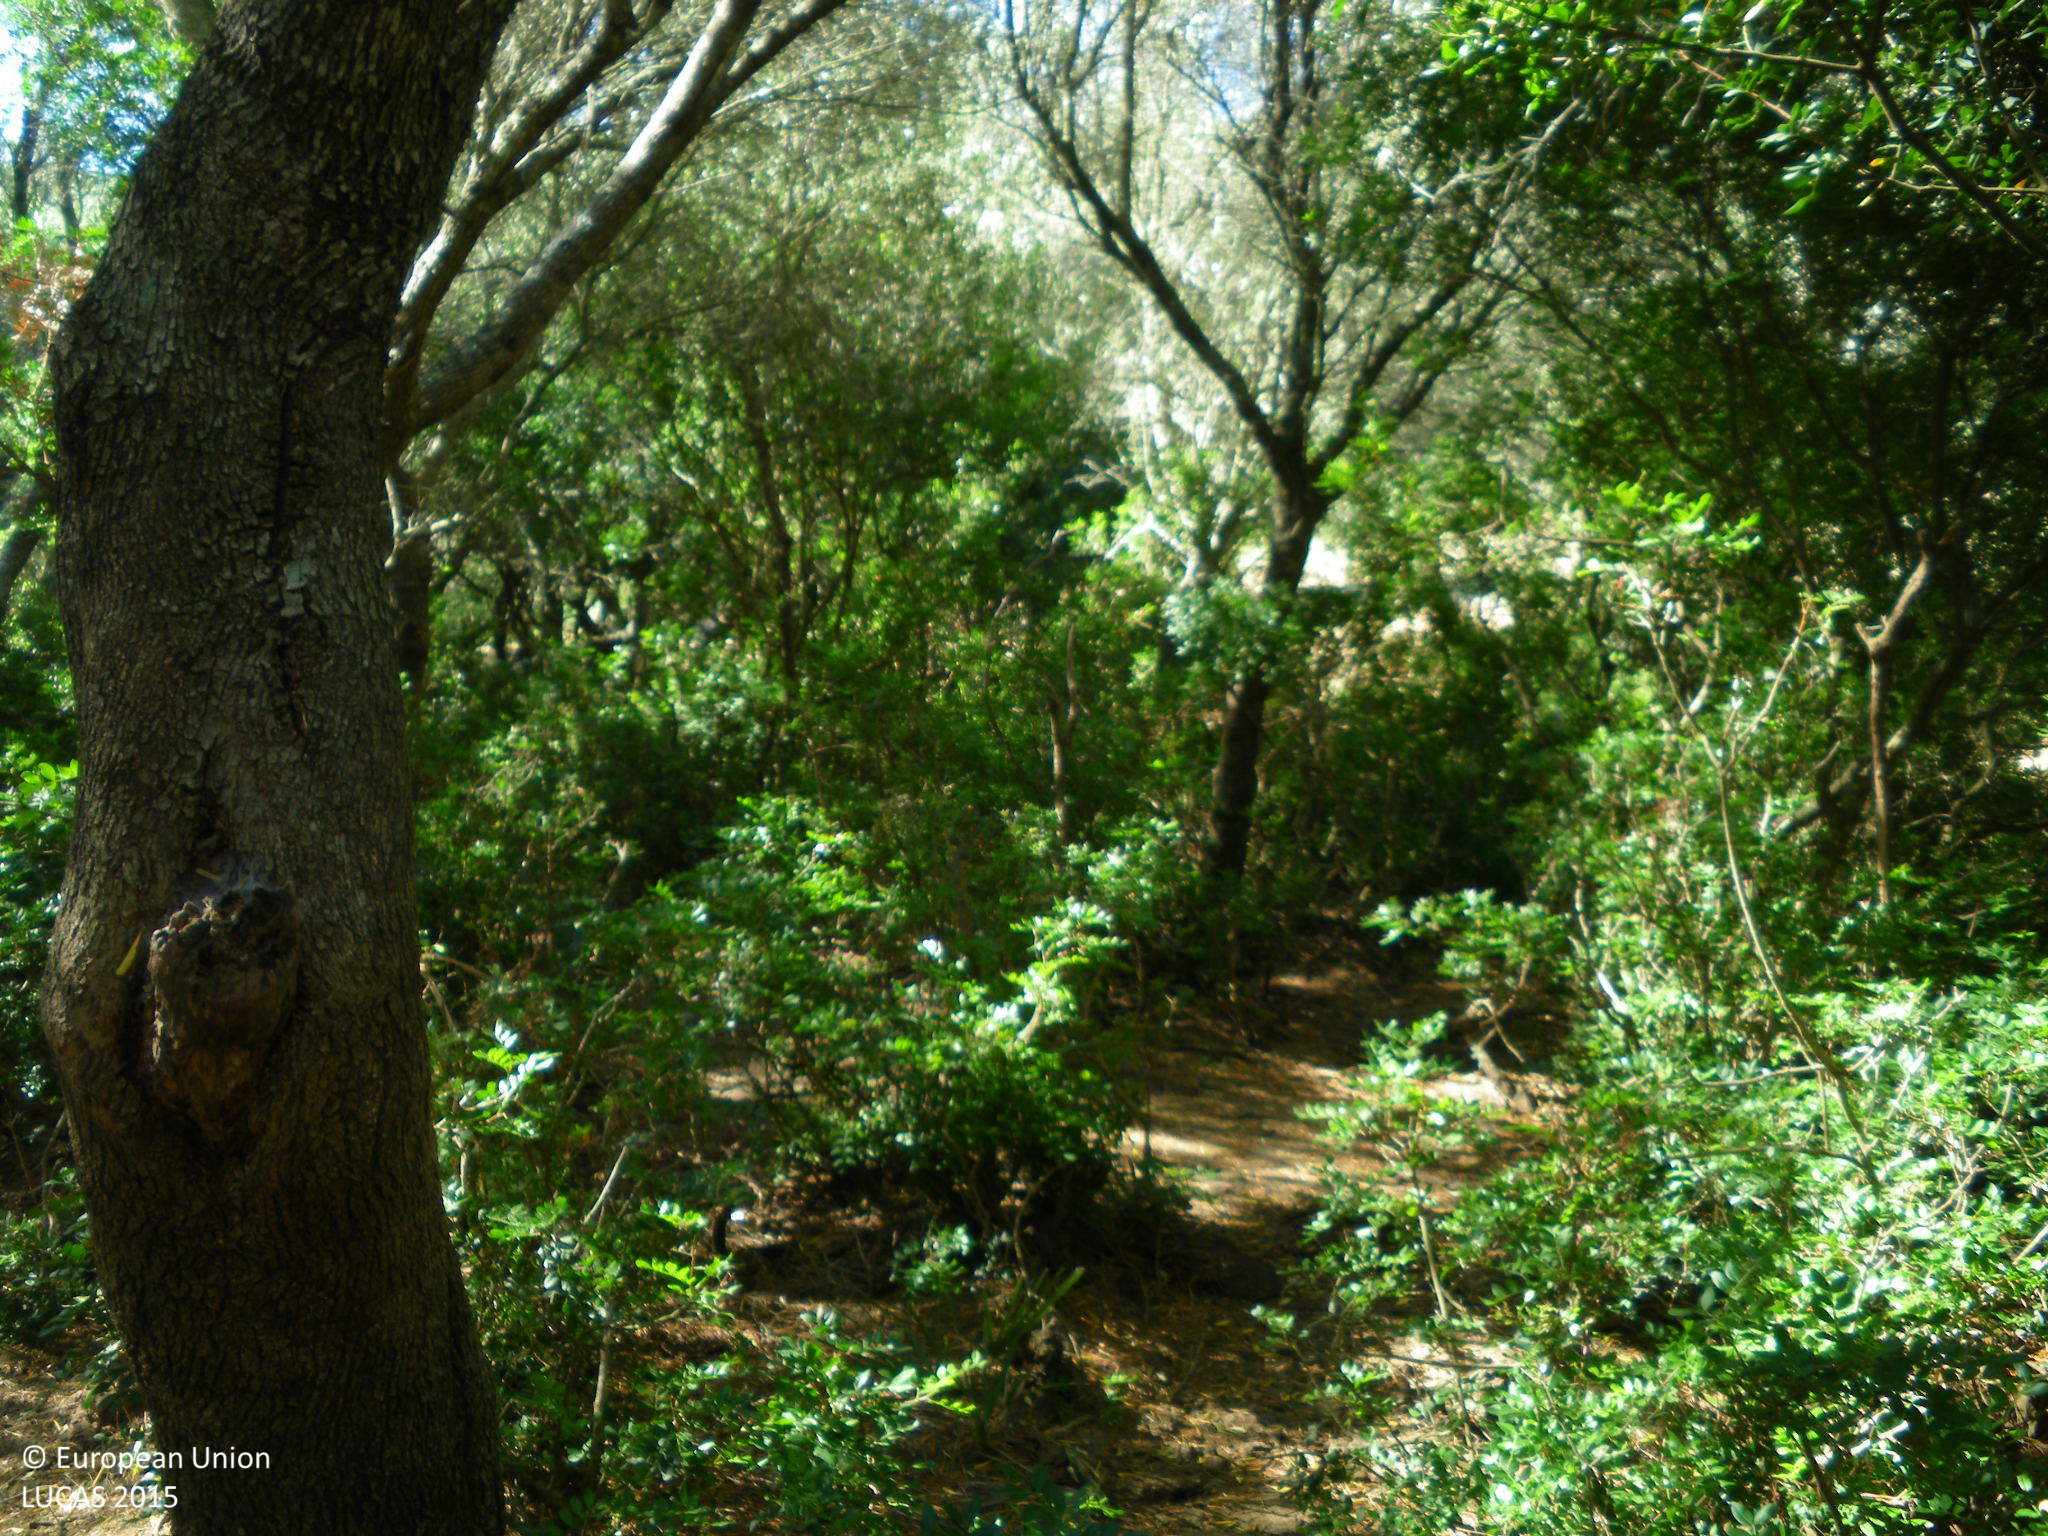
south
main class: Woodland
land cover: Broadleaved woodland
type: broadleaved evergreen forest
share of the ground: > 75 %
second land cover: Shrubland without tree cover
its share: 50 - 75 %
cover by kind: broadleaved forest trees 75 %, herbaceous plants 15 %, shrubs 5 %, unconsolidated bare surface 5 %
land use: Forestry
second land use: Agriculture (excluding fallow land and kitchen gardens)
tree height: > 5 m
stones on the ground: < 10 %
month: June
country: ES
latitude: 36.1252
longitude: -5.7844
